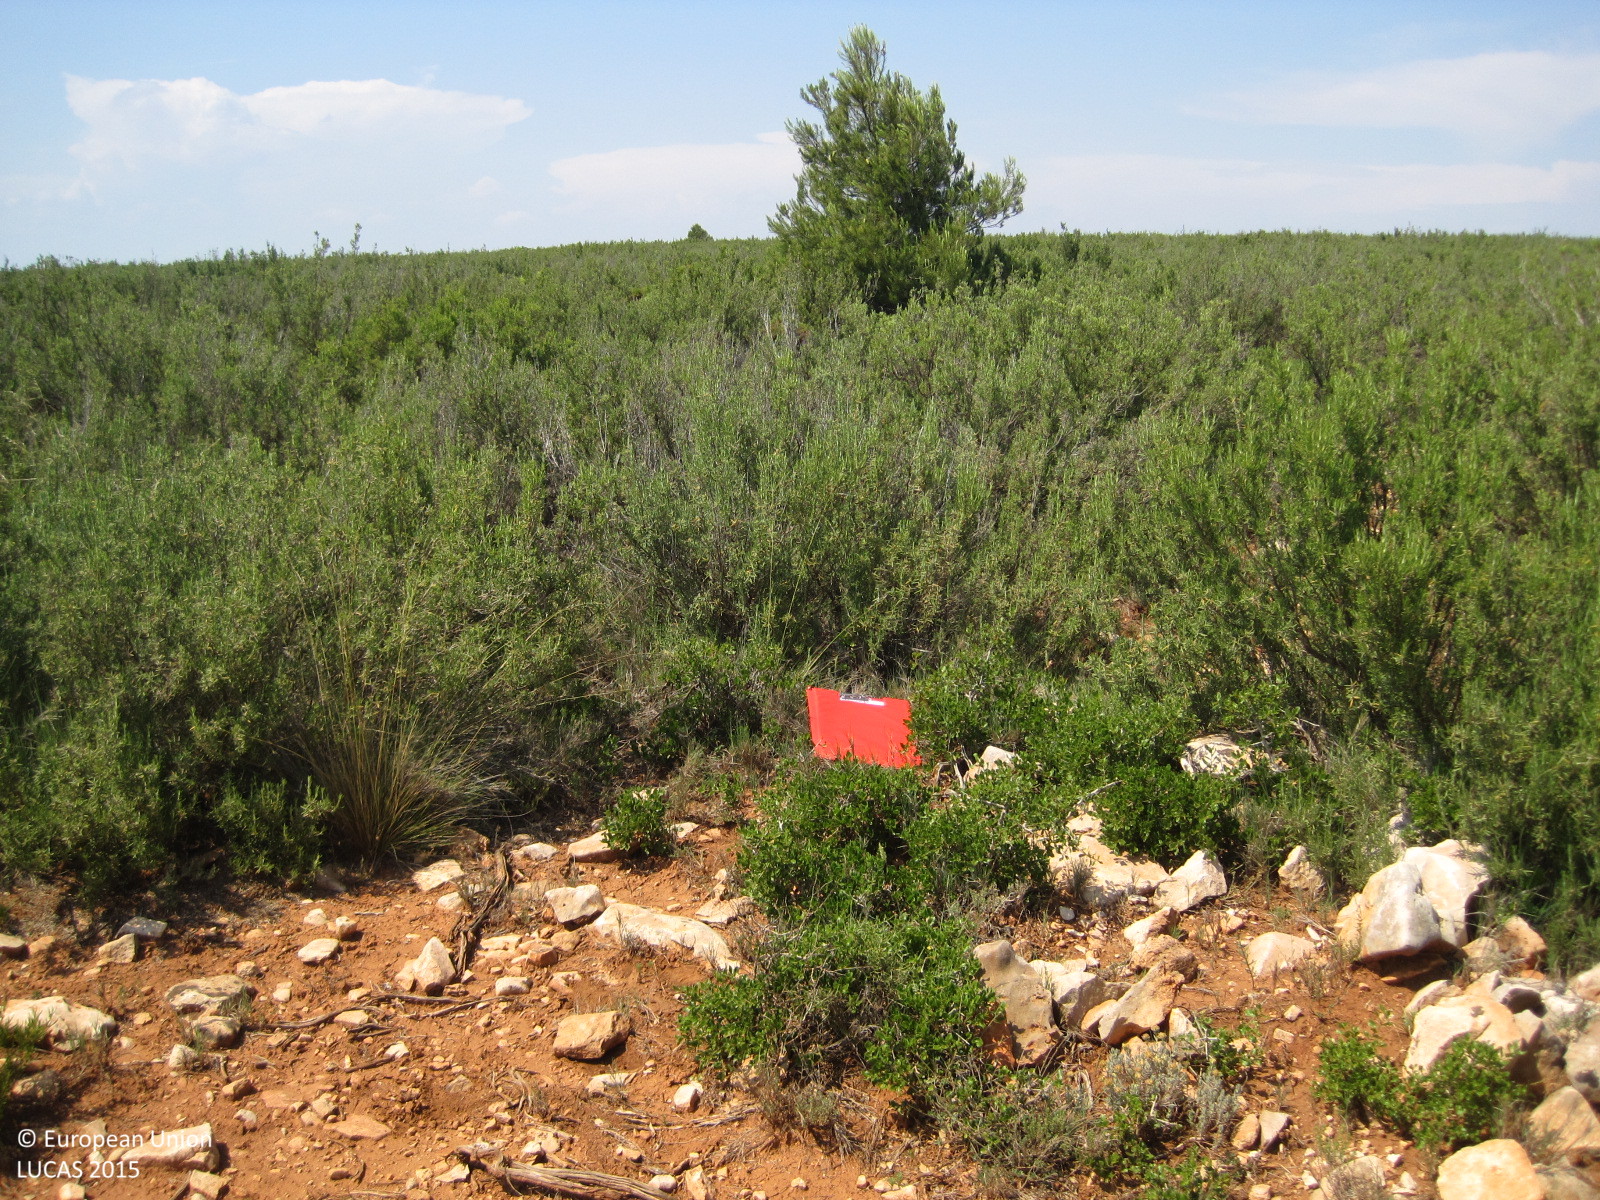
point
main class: Shrubland
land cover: Shrubland without tree cover
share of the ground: > 75 %
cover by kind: shrubs 85 %, consolidated bare surface 10 %, herbaceous plants 5 %
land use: Semi-natural and natural areas not in use
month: June
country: ES
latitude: 39.2437
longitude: -0.8537
